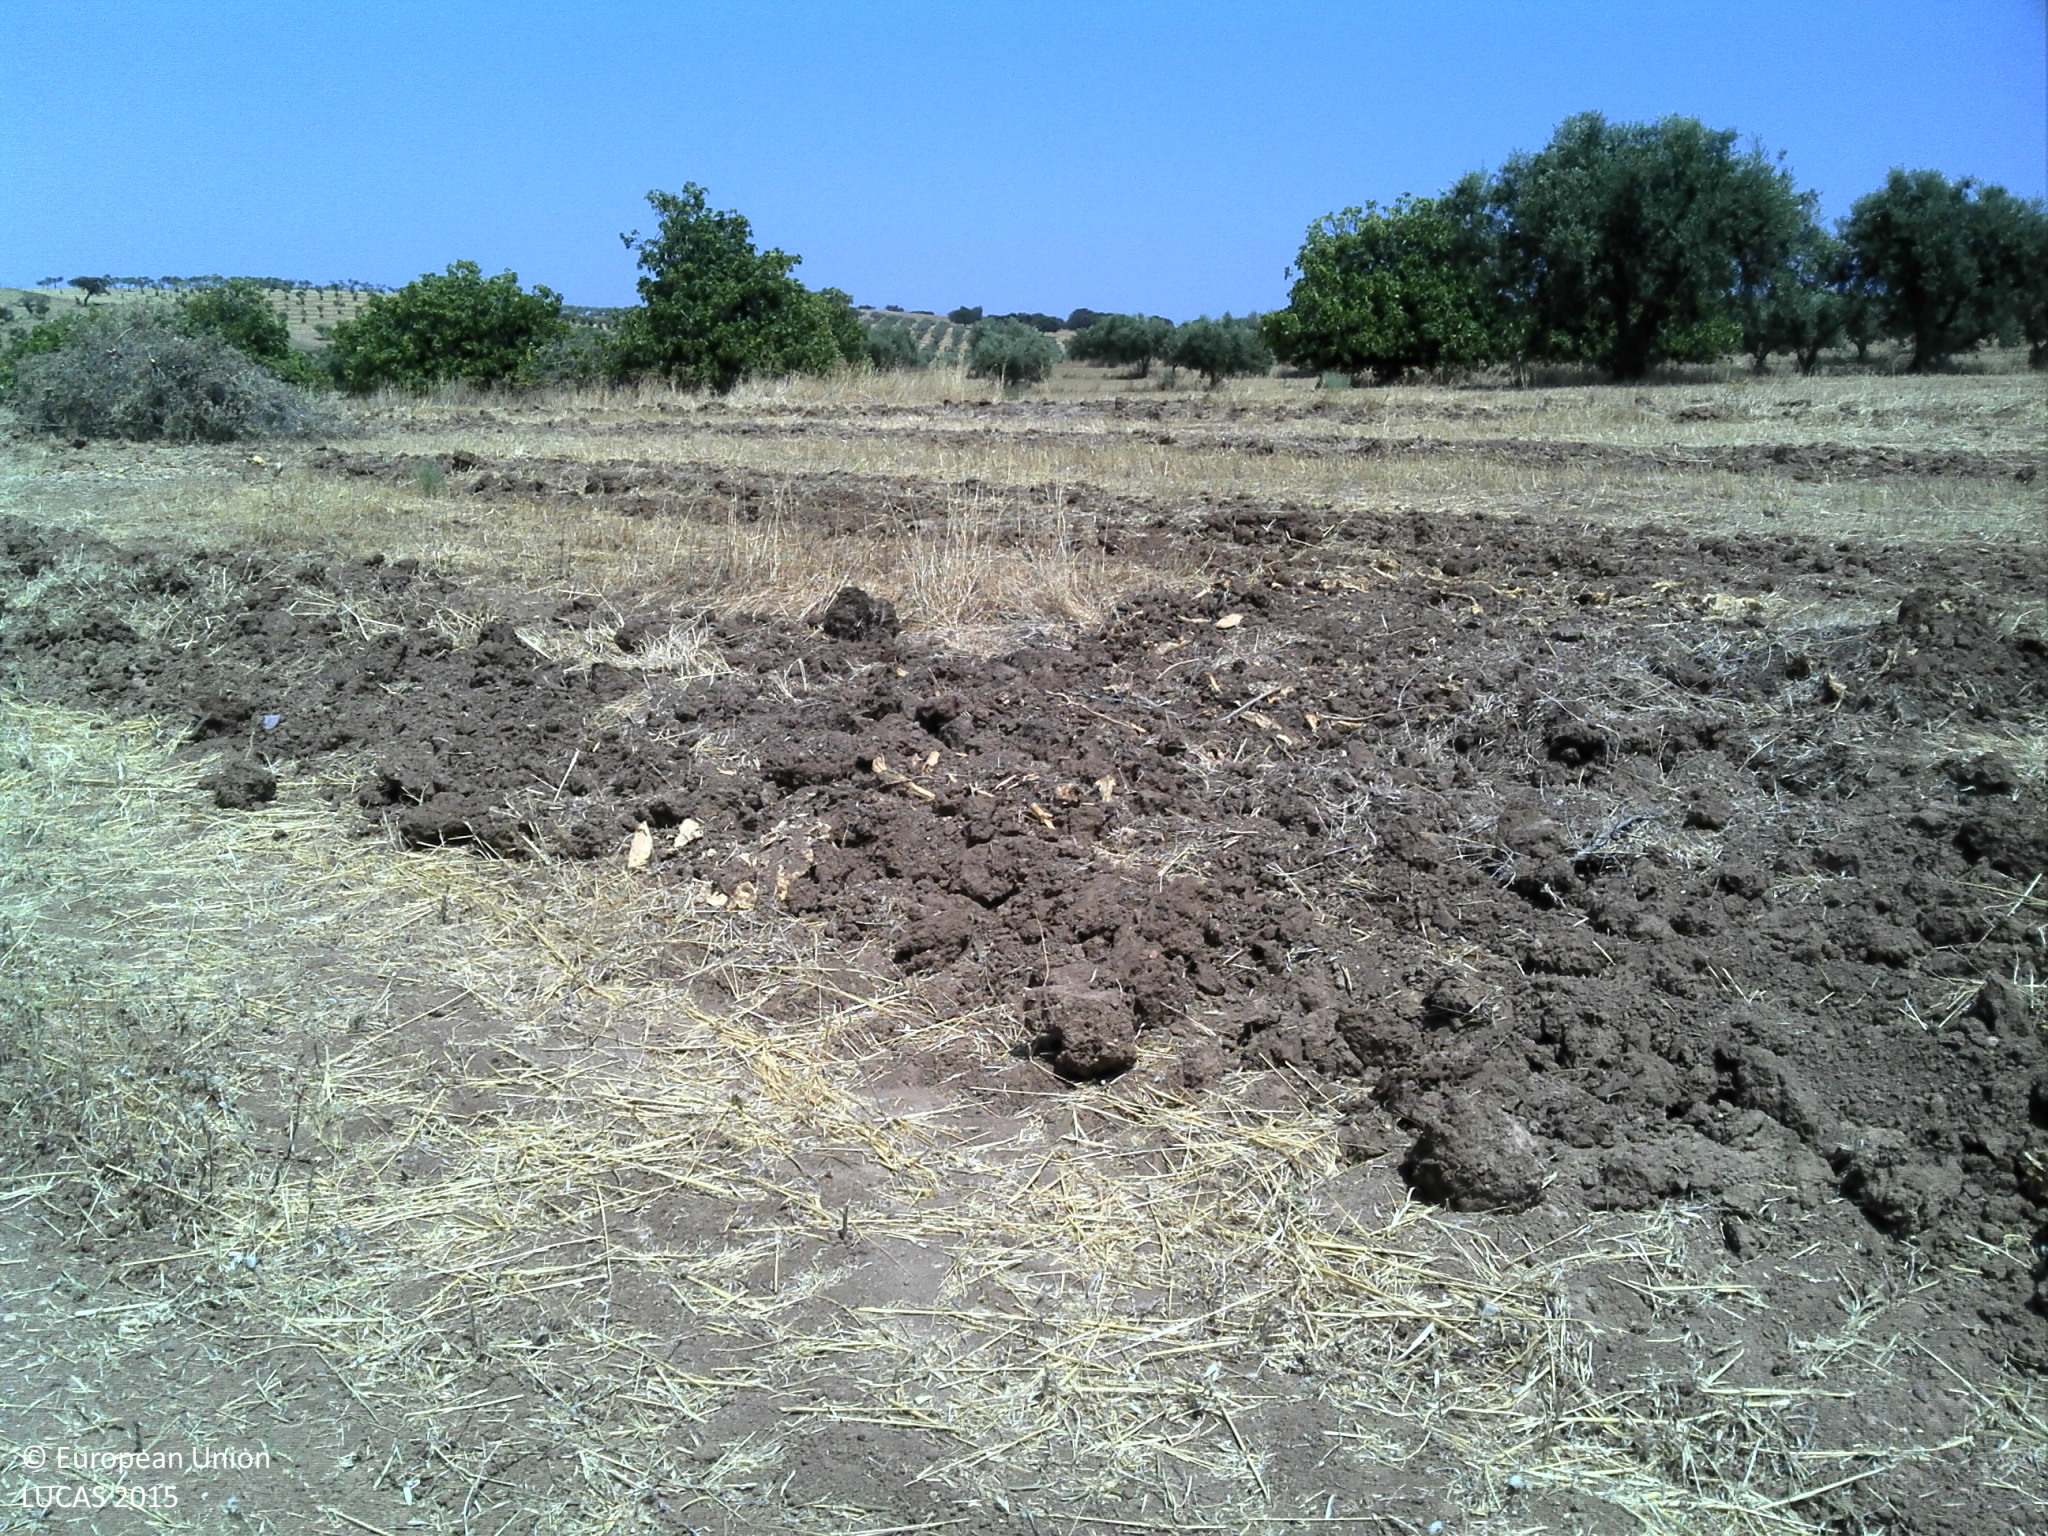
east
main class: Grassland
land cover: Grassland without tree/shrub cover
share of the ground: 10 - 25 %
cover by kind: herbaceous plants 95 %, unconsolidated bare surface 5 %
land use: Agriculture (excluding fallow land and kitchen gardens)
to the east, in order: Grassland without tree/shrub cover; Other fruit trees and berries; Olive groves; Grass margins; Tracks; Olive groves
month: June
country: PT
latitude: 38.2240
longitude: -7.3719
